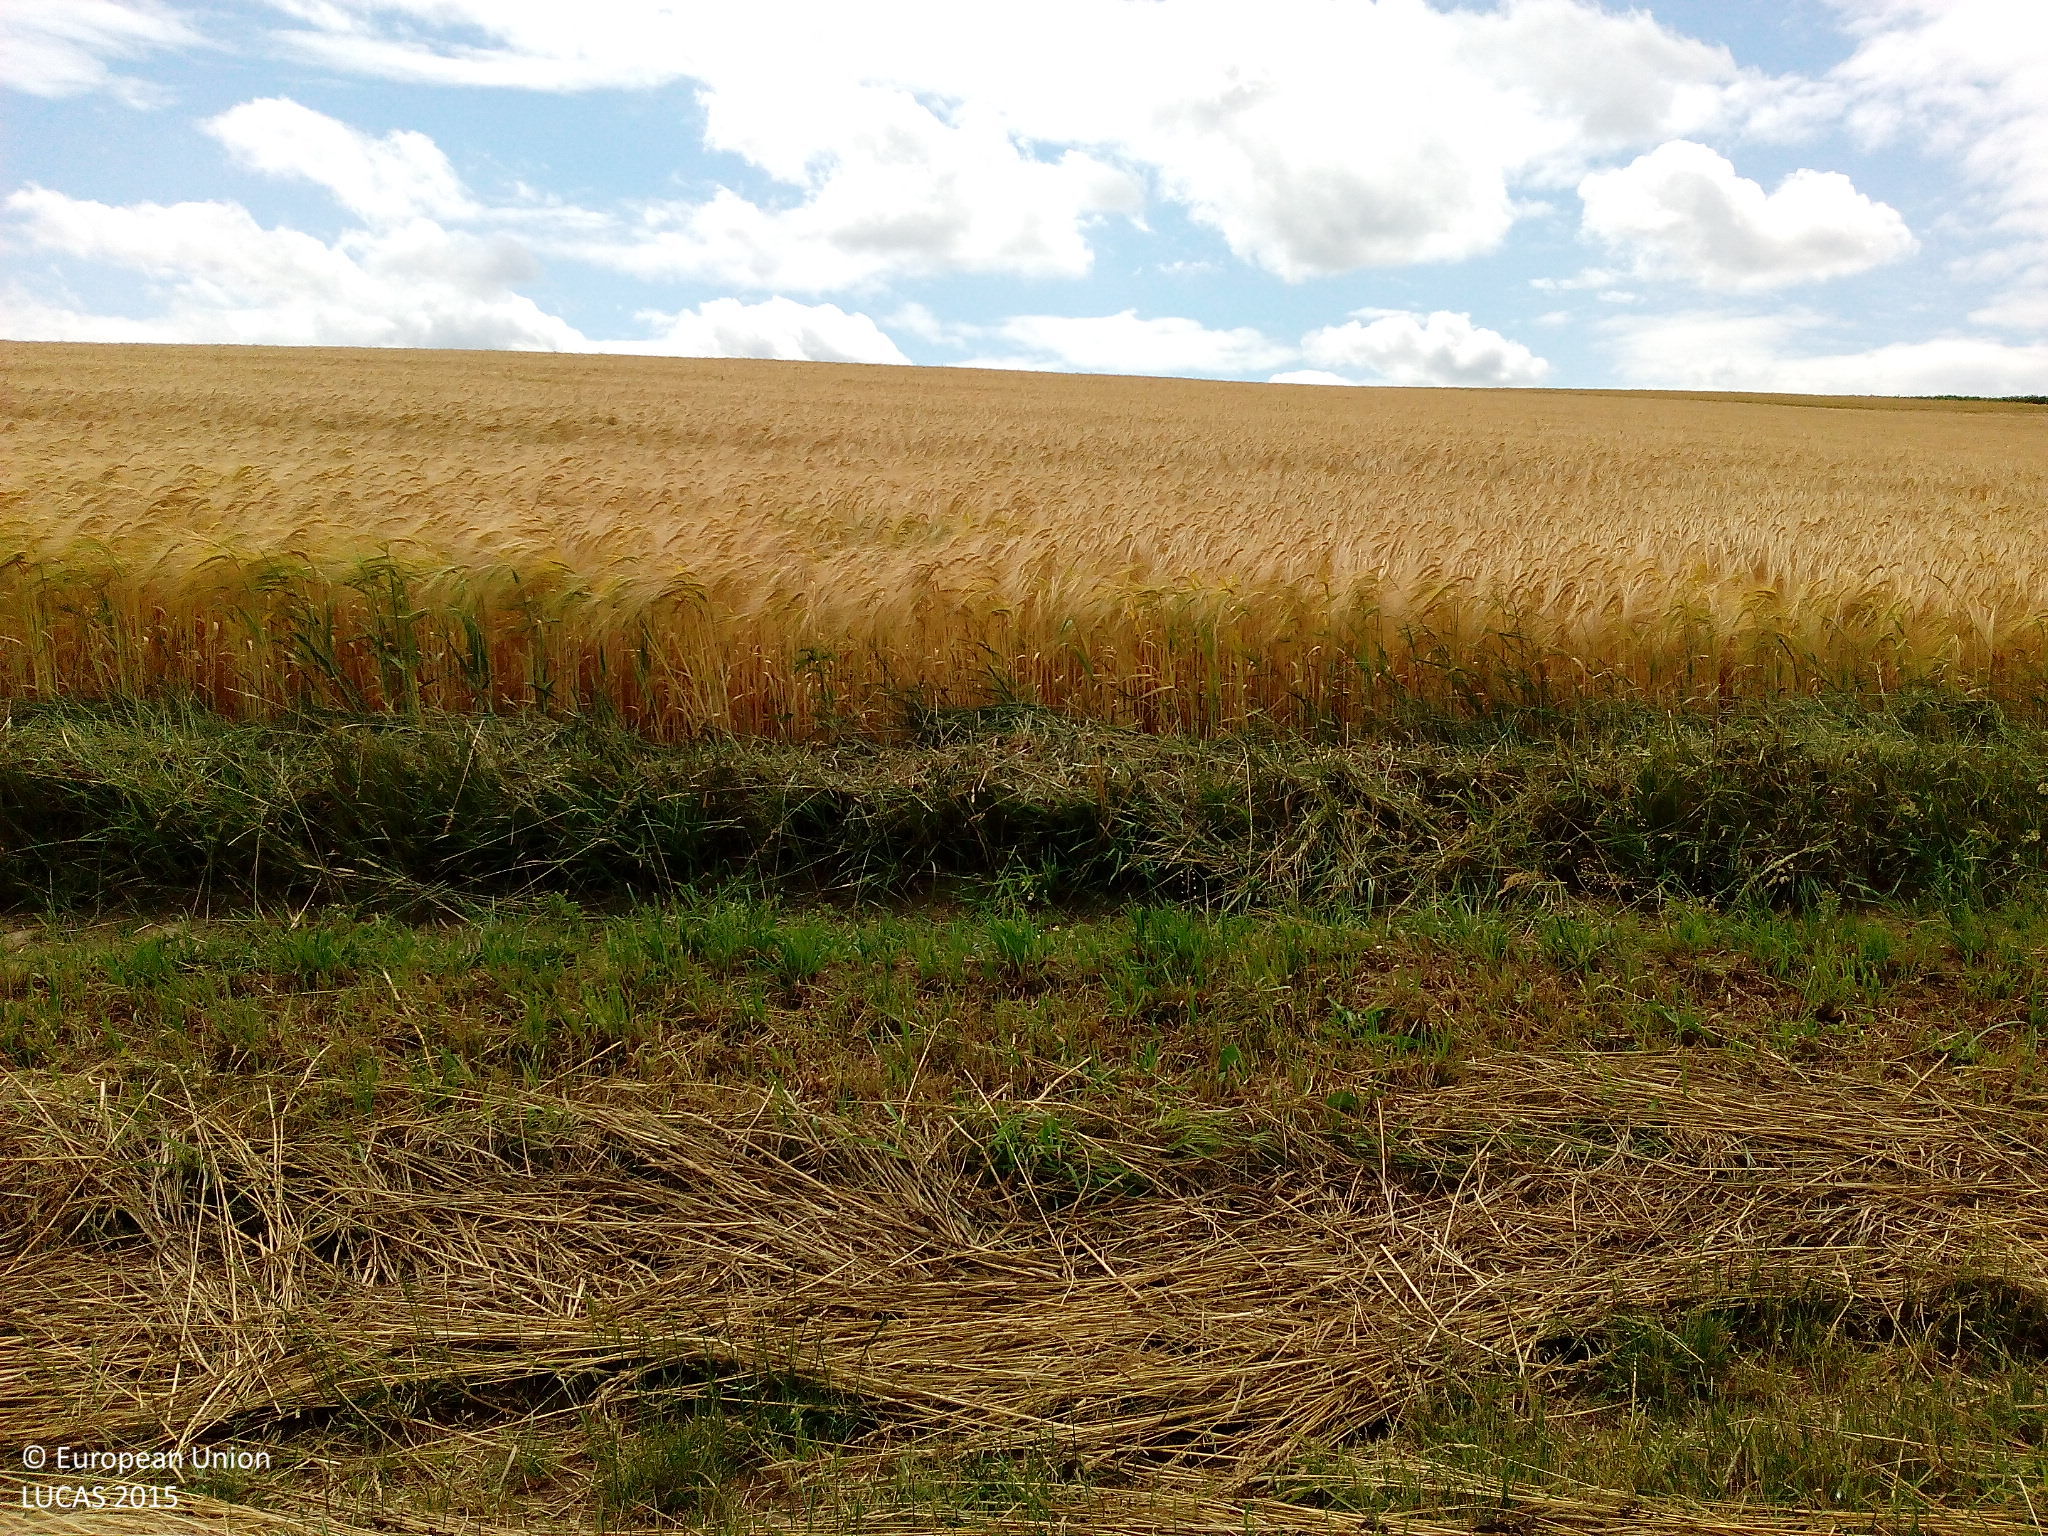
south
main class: Cropland
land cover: Barley
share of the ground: > 75 %
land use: Agriculture (excluding fallow land and kitchen gardens)
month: July
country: DE
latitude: 51.0651
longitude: 9.8431
